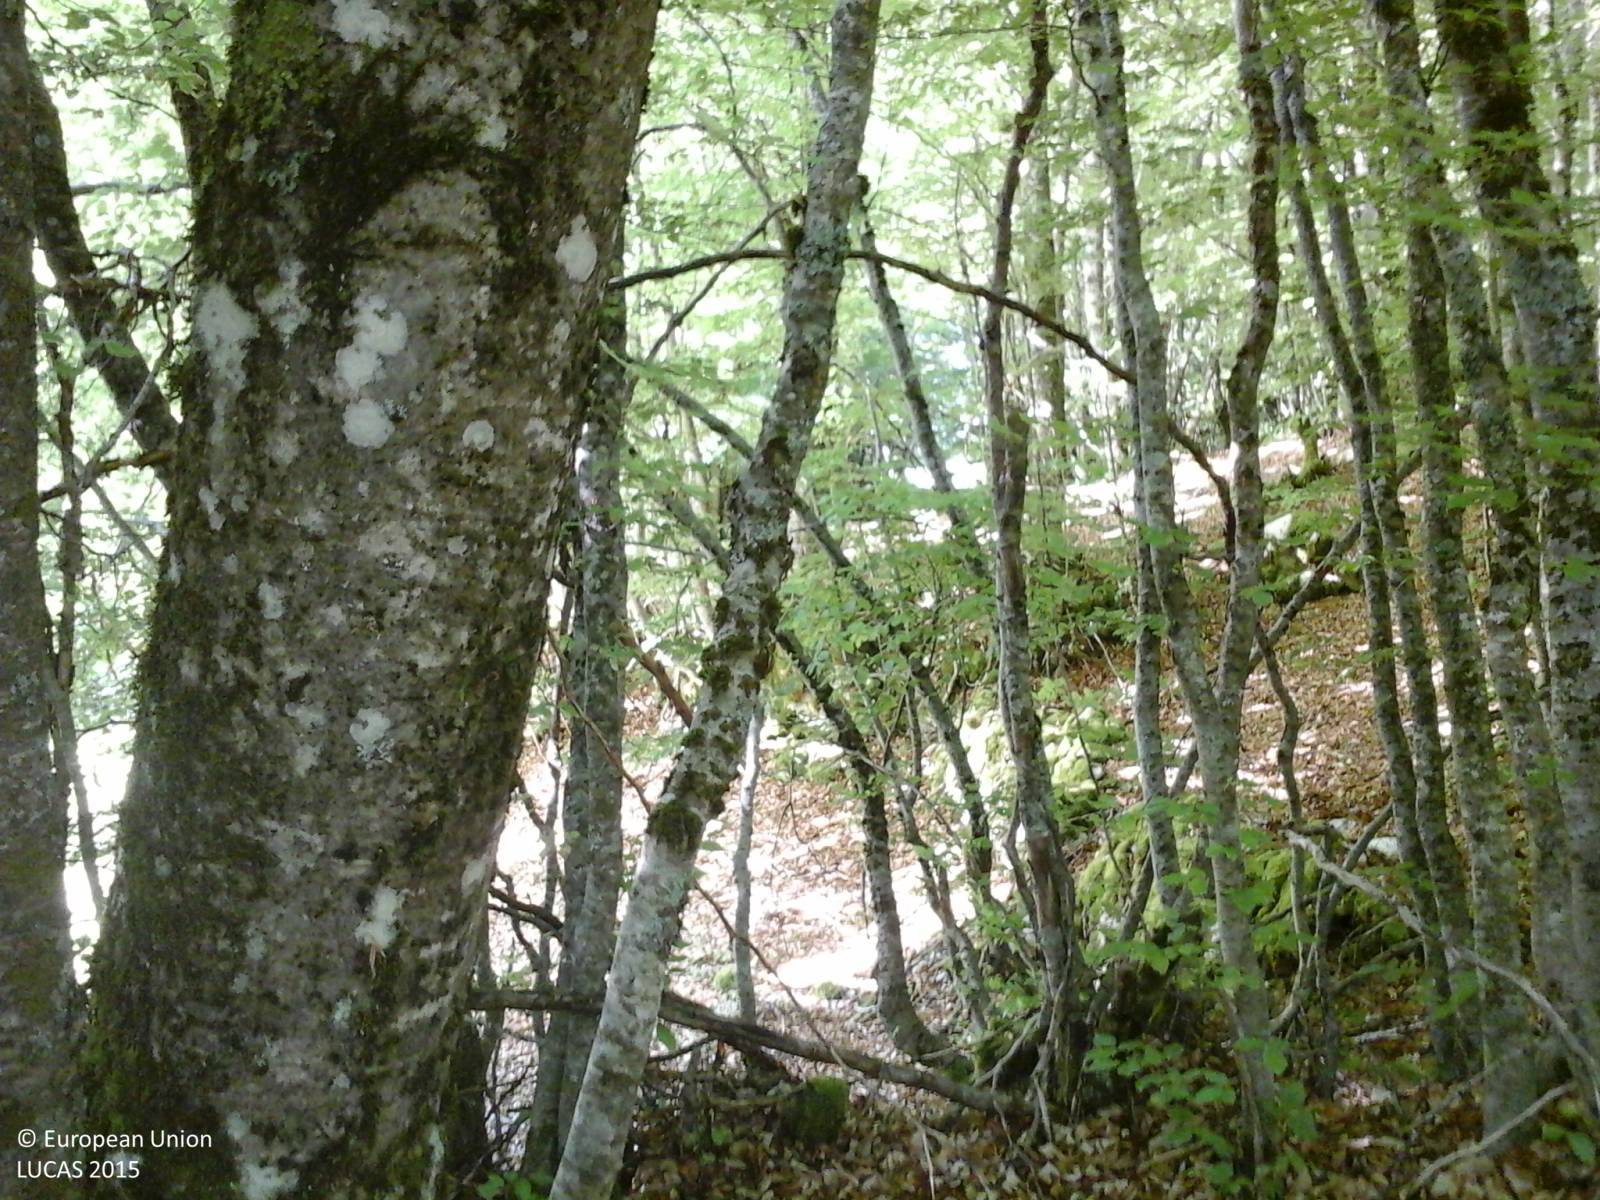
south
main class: Woodland
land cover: Broadleaved woodland
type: mountainous beech forest
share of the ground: > 75 %
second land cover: Grassland without tree/shrub cover
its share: 10 - 25 %
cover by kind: broadleaved forest trees 60 %, unconsolidated bare surface 25 %, herbaceous plants 15 %
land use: Forestry
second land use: Agriculture (excluding fallow land and kitchen gardens)
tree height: > 5 m
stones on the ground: < 10 %
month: May
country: IT
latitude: 41.7879
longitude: 13.7769
